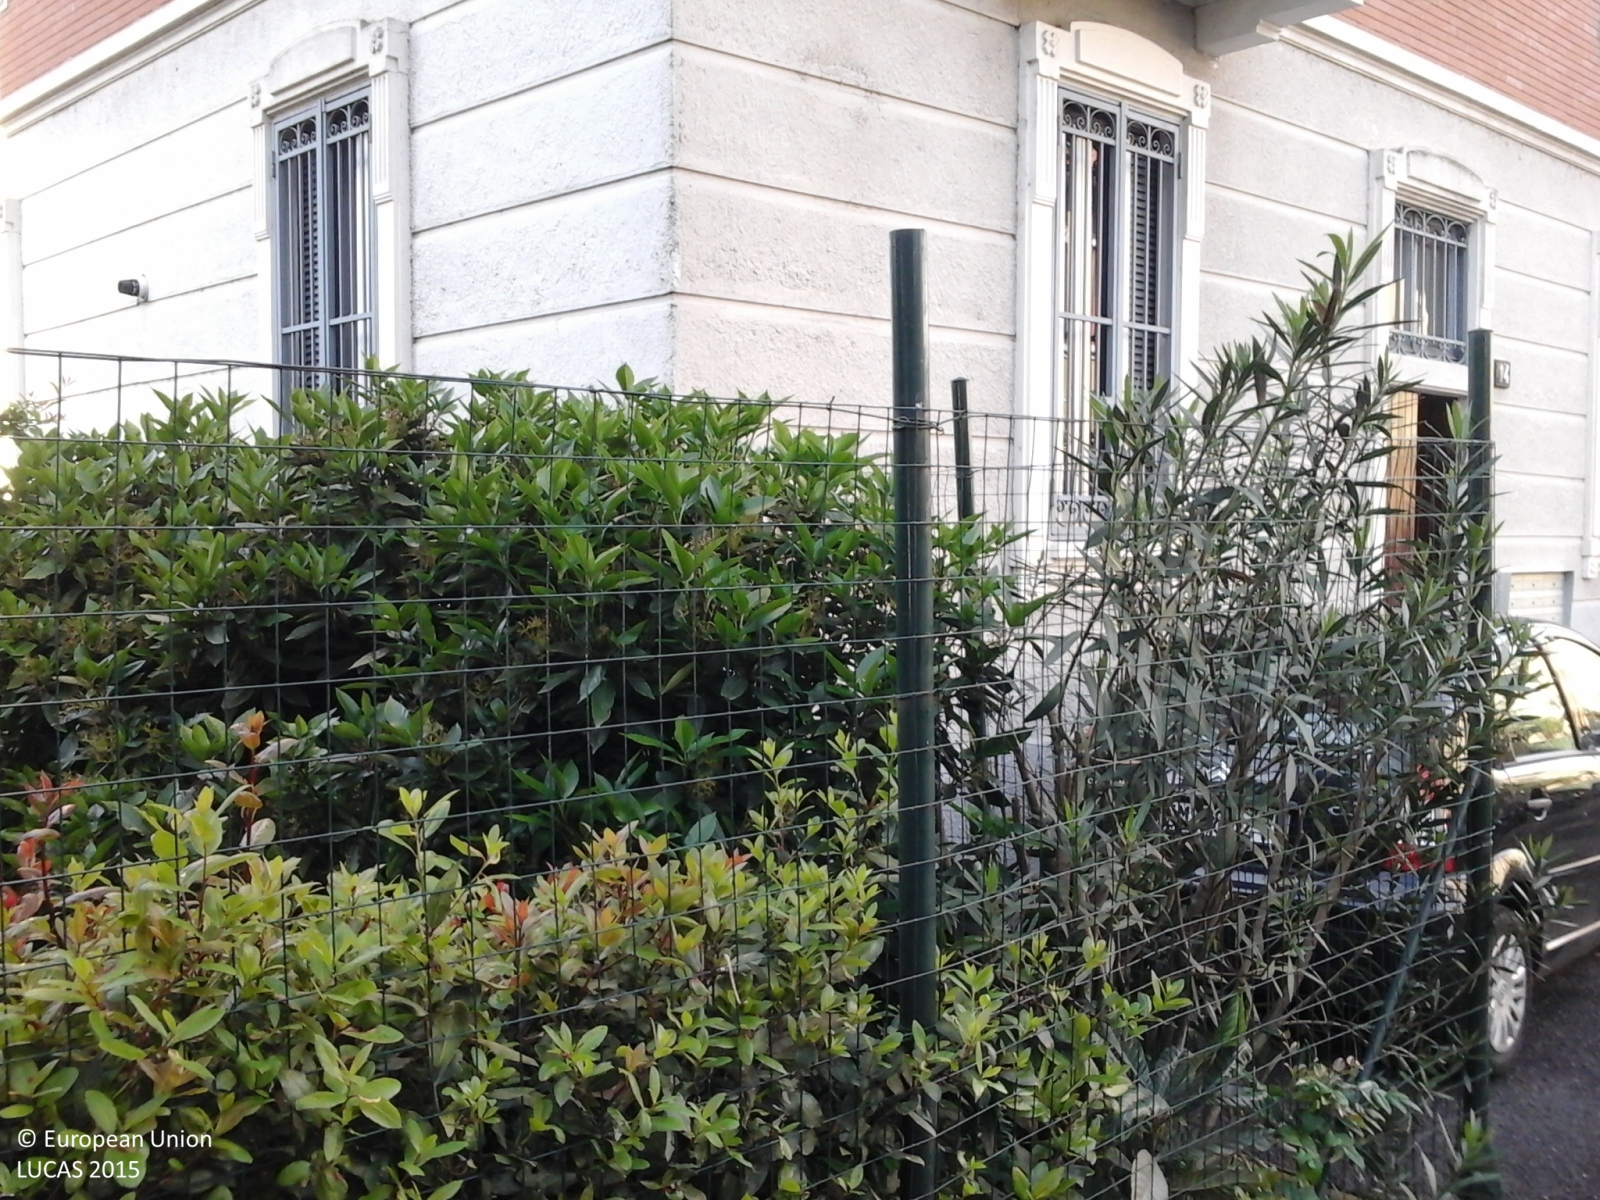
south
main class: Woodland
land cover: Broadleaved woodland
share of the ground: 50 - 75 %
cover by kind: broadleaved forest trees 50 %, shrubs 30 %, herbaceous plants 20 %
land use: Residential
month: May
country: IT
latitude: 45.4645
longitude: 9.0935
